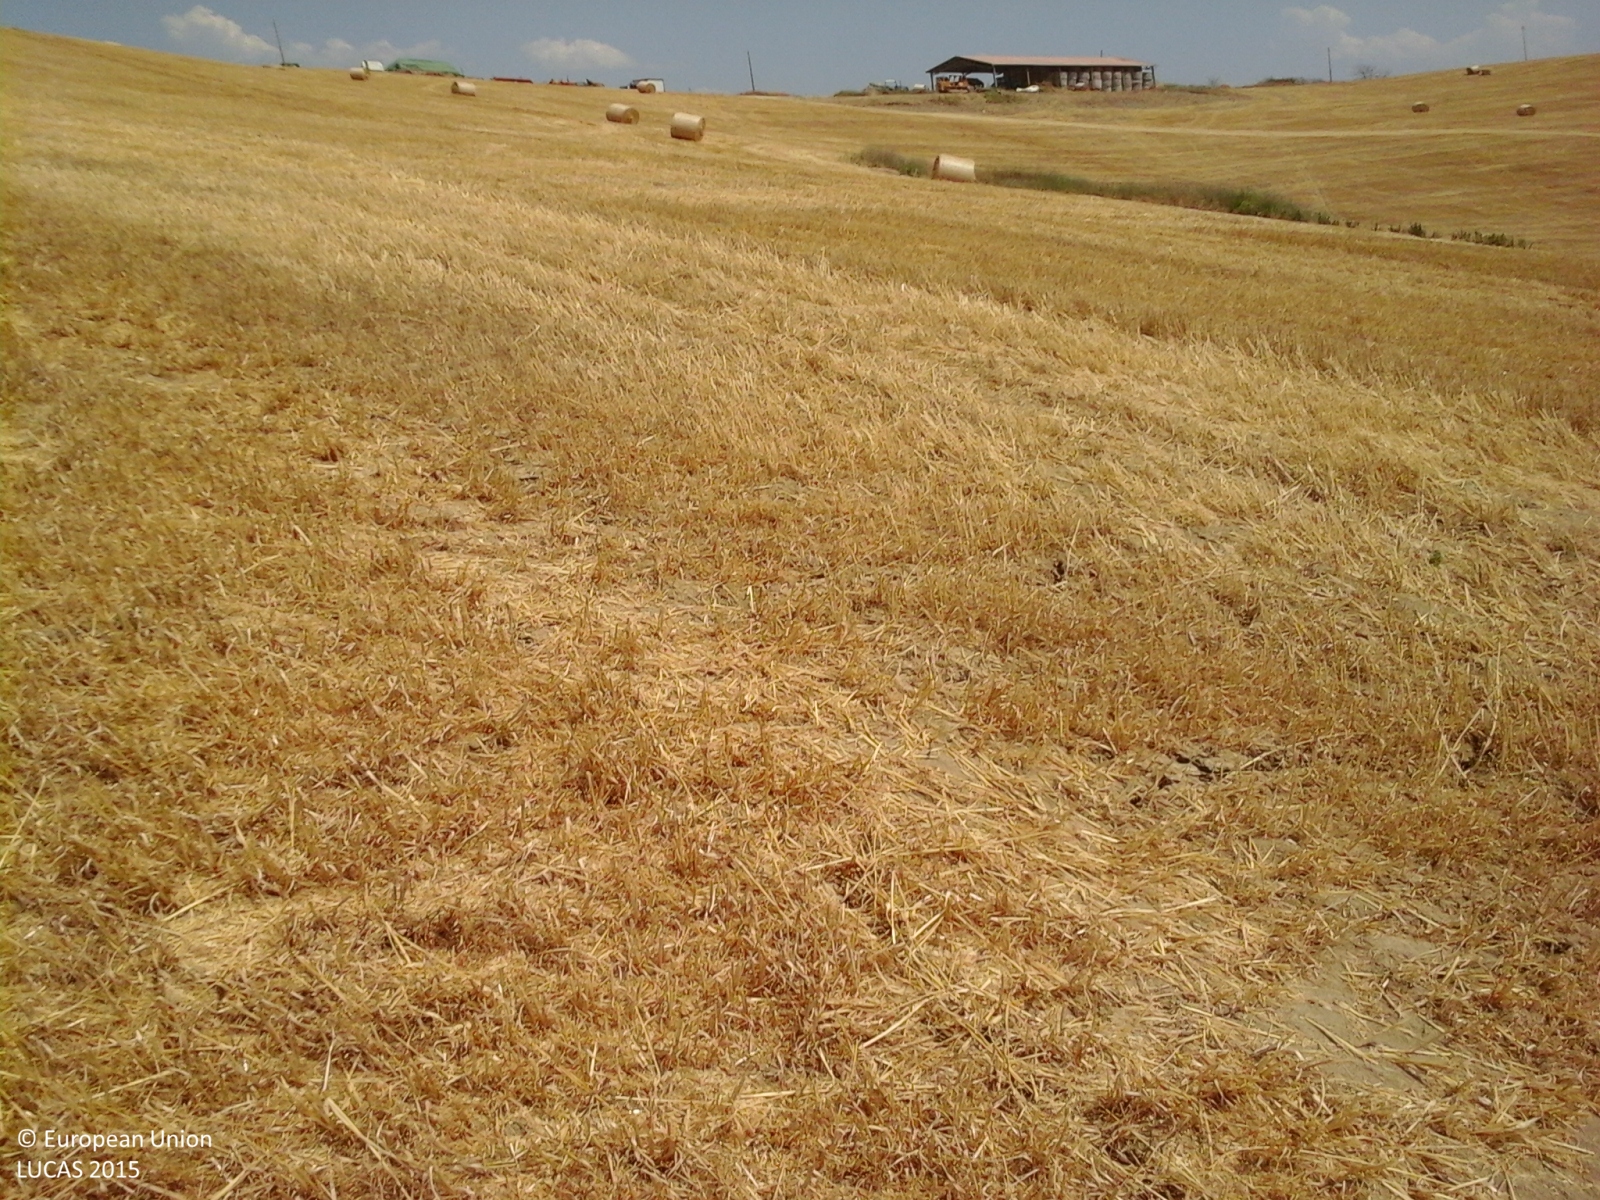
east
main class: Cropland
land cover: Durum wheat
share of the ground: > 75 %
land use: Agriculture (excluding fallow land and kitchen gardens)
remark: Harvested field
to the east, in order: Durum wheat; Tracks; Electric lines; Grass margins; Tracks; Temporary grasslands
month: July
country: IT
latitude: 43.1105
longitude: 11.6295
